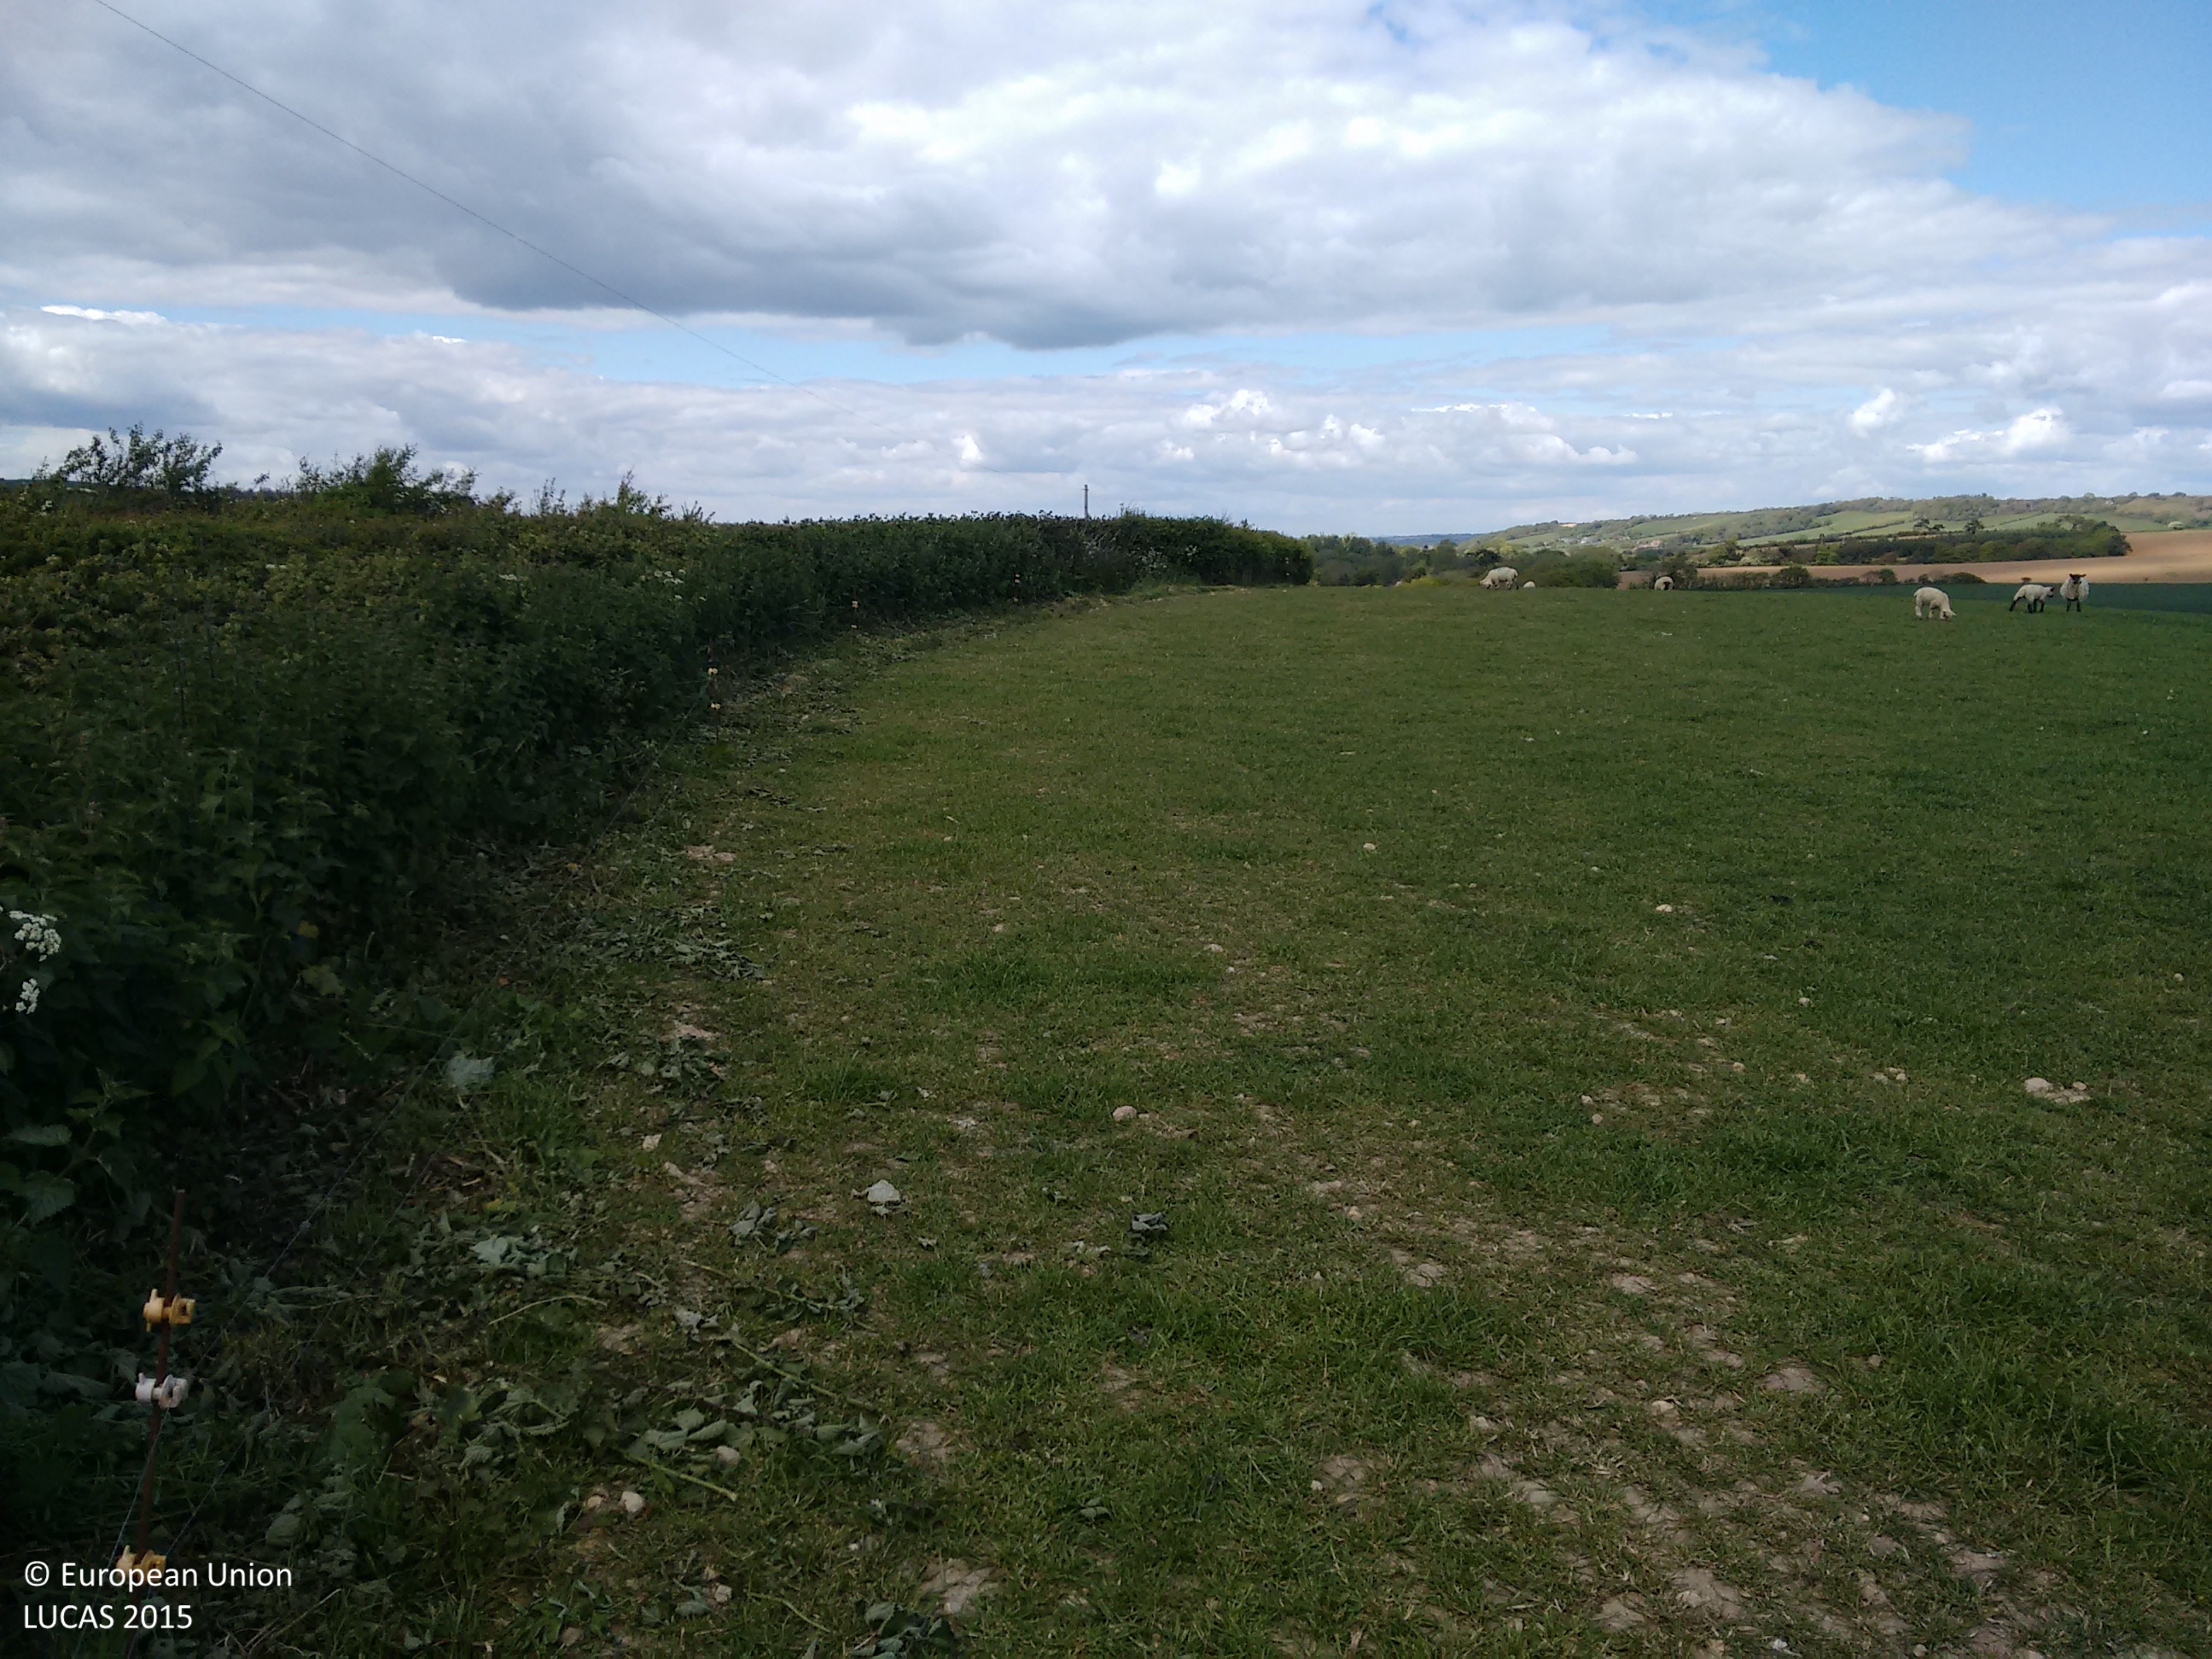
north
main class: Grassland
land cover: Grassland without tree/shrub cover
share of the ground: > 75 %
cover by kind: herbaceous plants 75 %, unconsolidated bare surface 25 %
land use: Agriculture (excluding fallow land and kitchen gardens)
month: May
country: GB
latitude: 50.6562
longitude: -1.2934
